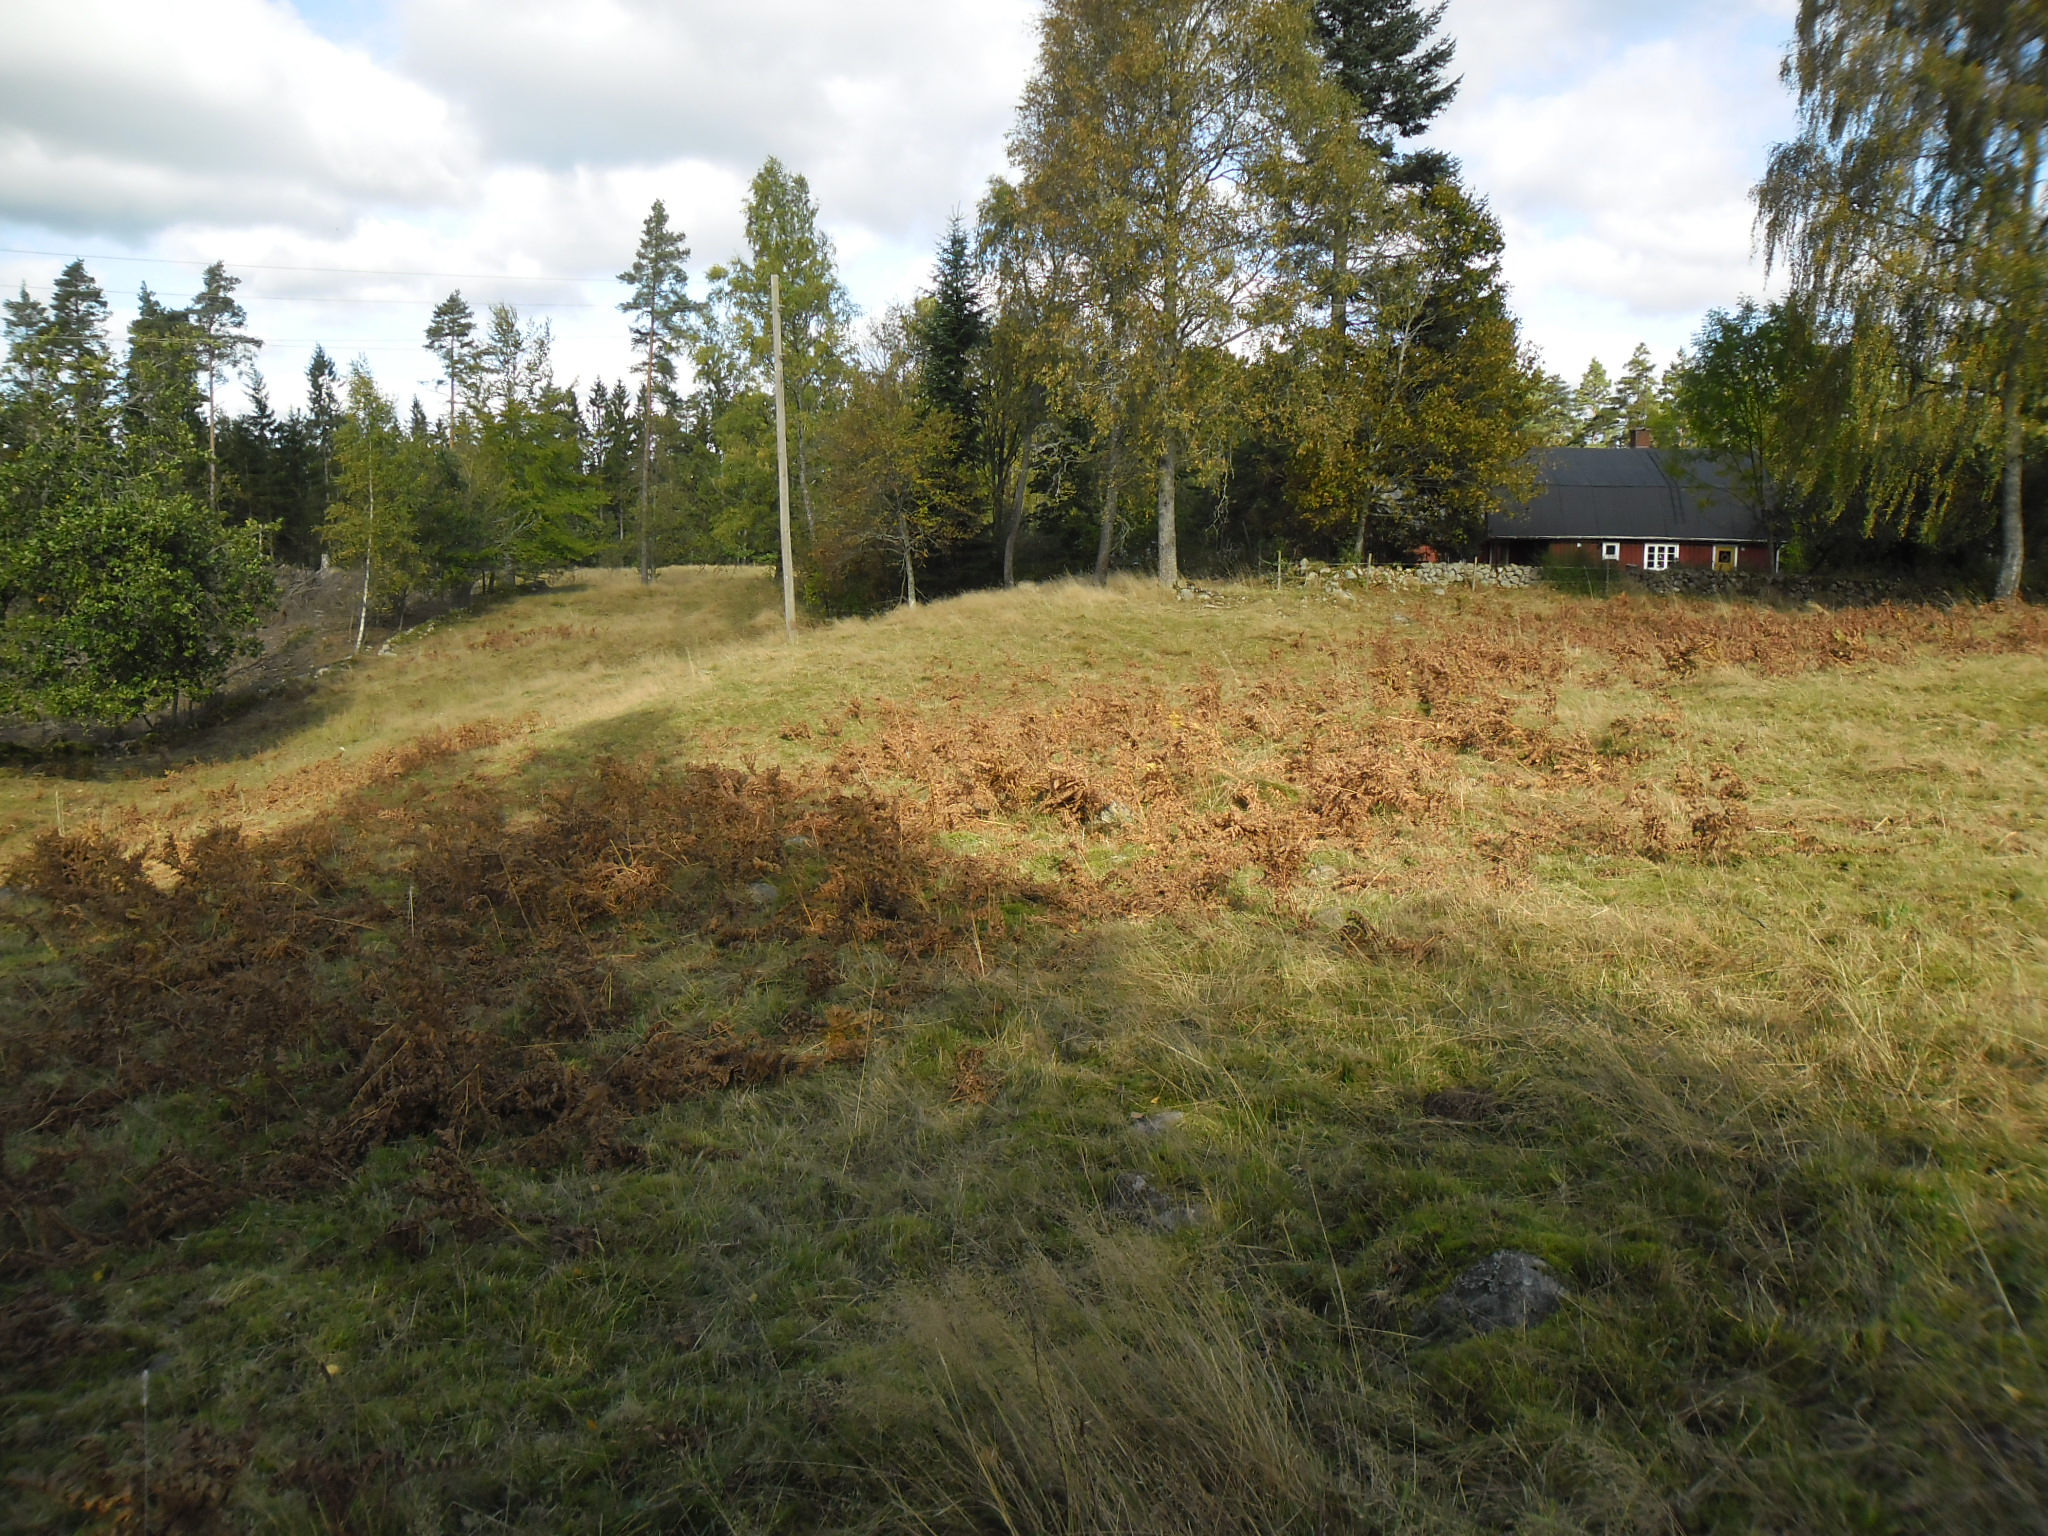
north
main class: Grassland
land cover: Grassland without tree/shrub cover
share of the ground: > 75 %
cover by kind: herbaceous plants 100 %
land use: Agriculture (excluding fallow land and kitchen gardens)
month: October
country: SE
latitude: 56.6897
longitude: 13.1152
